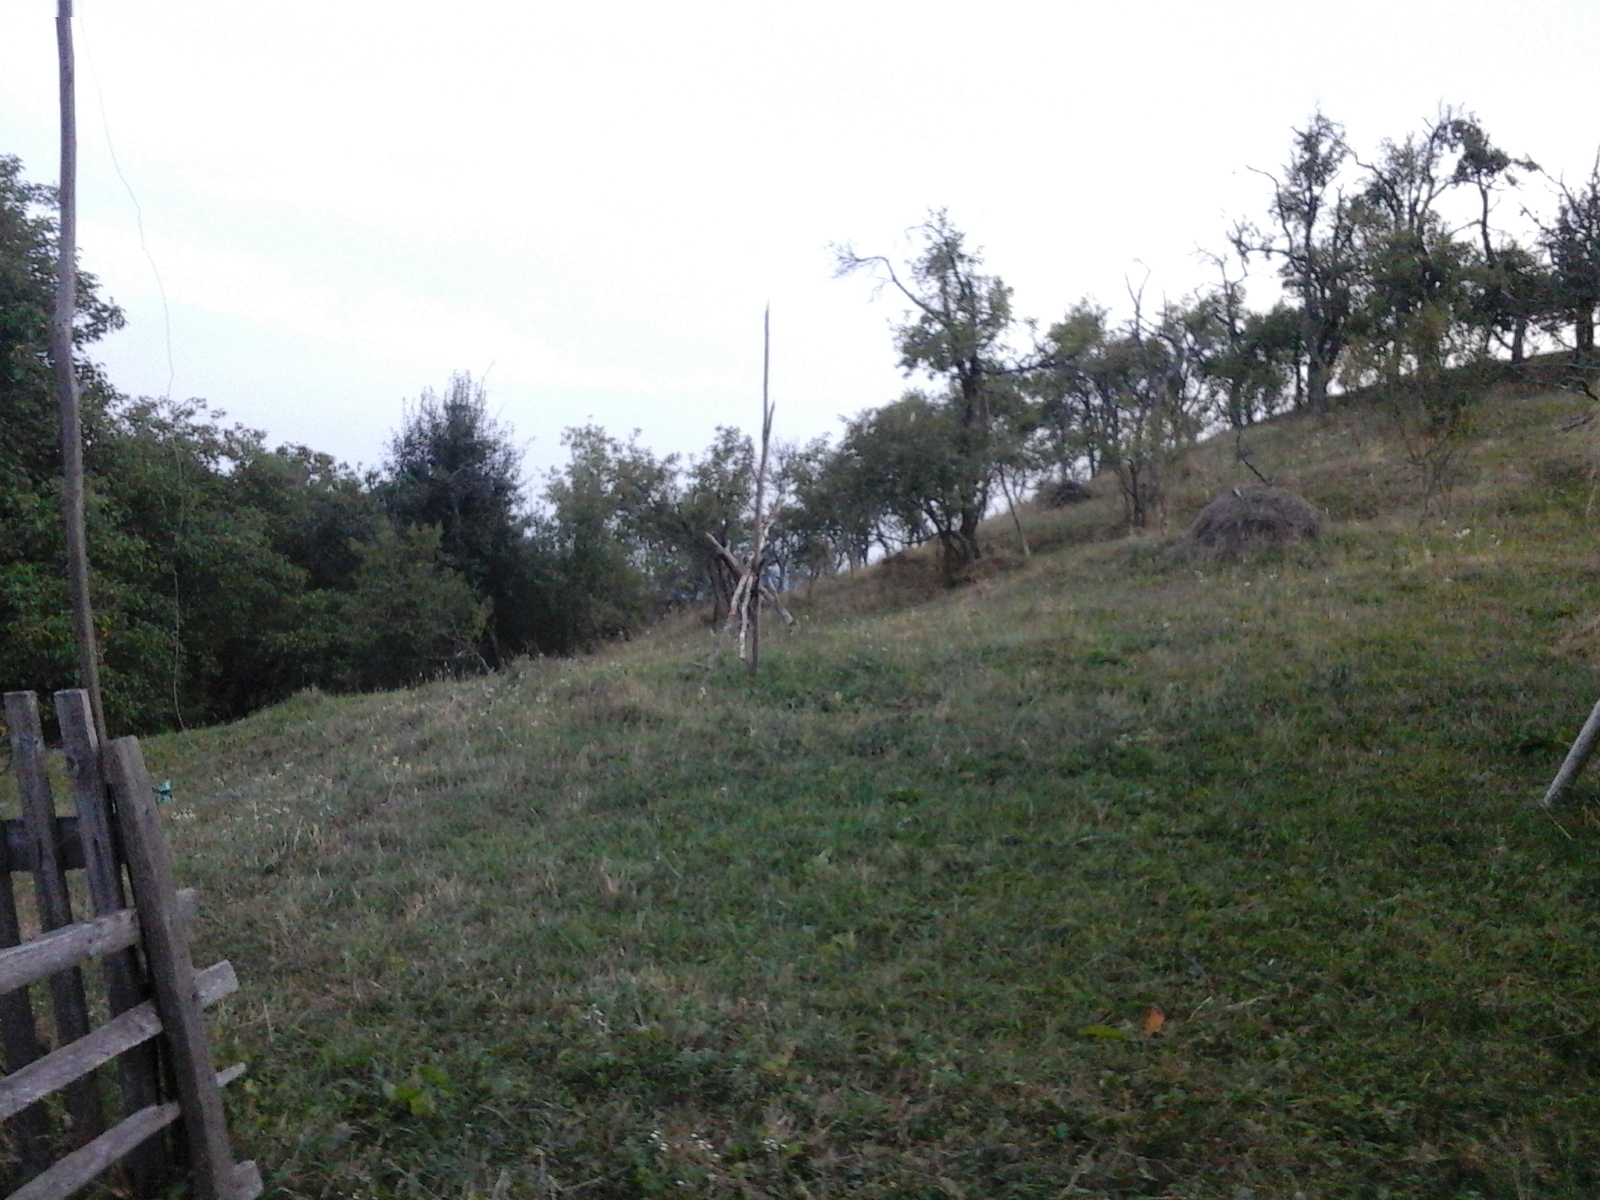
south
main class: Cropland
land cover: Nuts trees
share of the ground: > 75 %
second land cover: Grassland without tree/shrub cover
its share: > 75 %
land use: Agriculture (excluding fallow land and kitchen gardens)
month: September
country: RO
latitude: 47.4325
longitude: 24.1529
